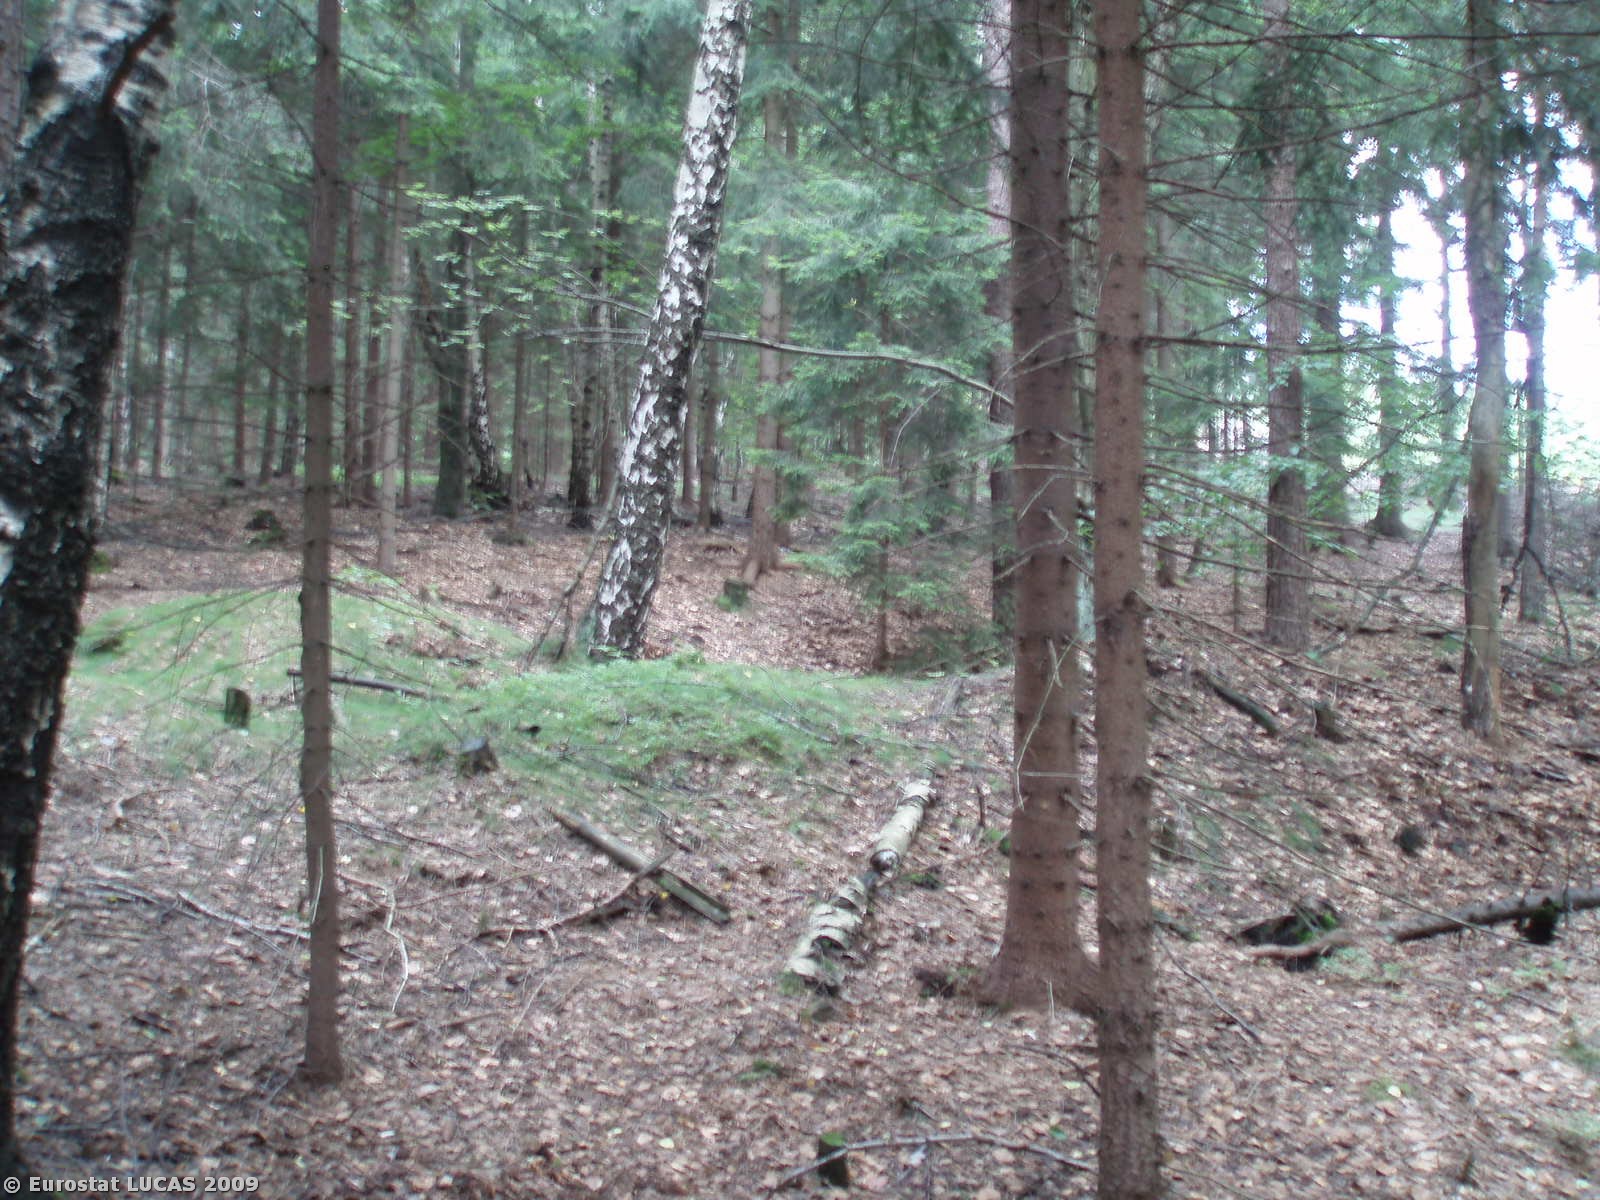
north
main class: Woodland
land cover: Mixed woodland
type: hemiboreal forest and nemoral coniferous forest and mixed broadleaved-coniferous forest
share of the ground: > 75 %
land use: Forestry
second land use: Nature reserves
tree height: > 5 m
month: July
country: CZ
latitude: 50.8269
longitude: 14.6729
